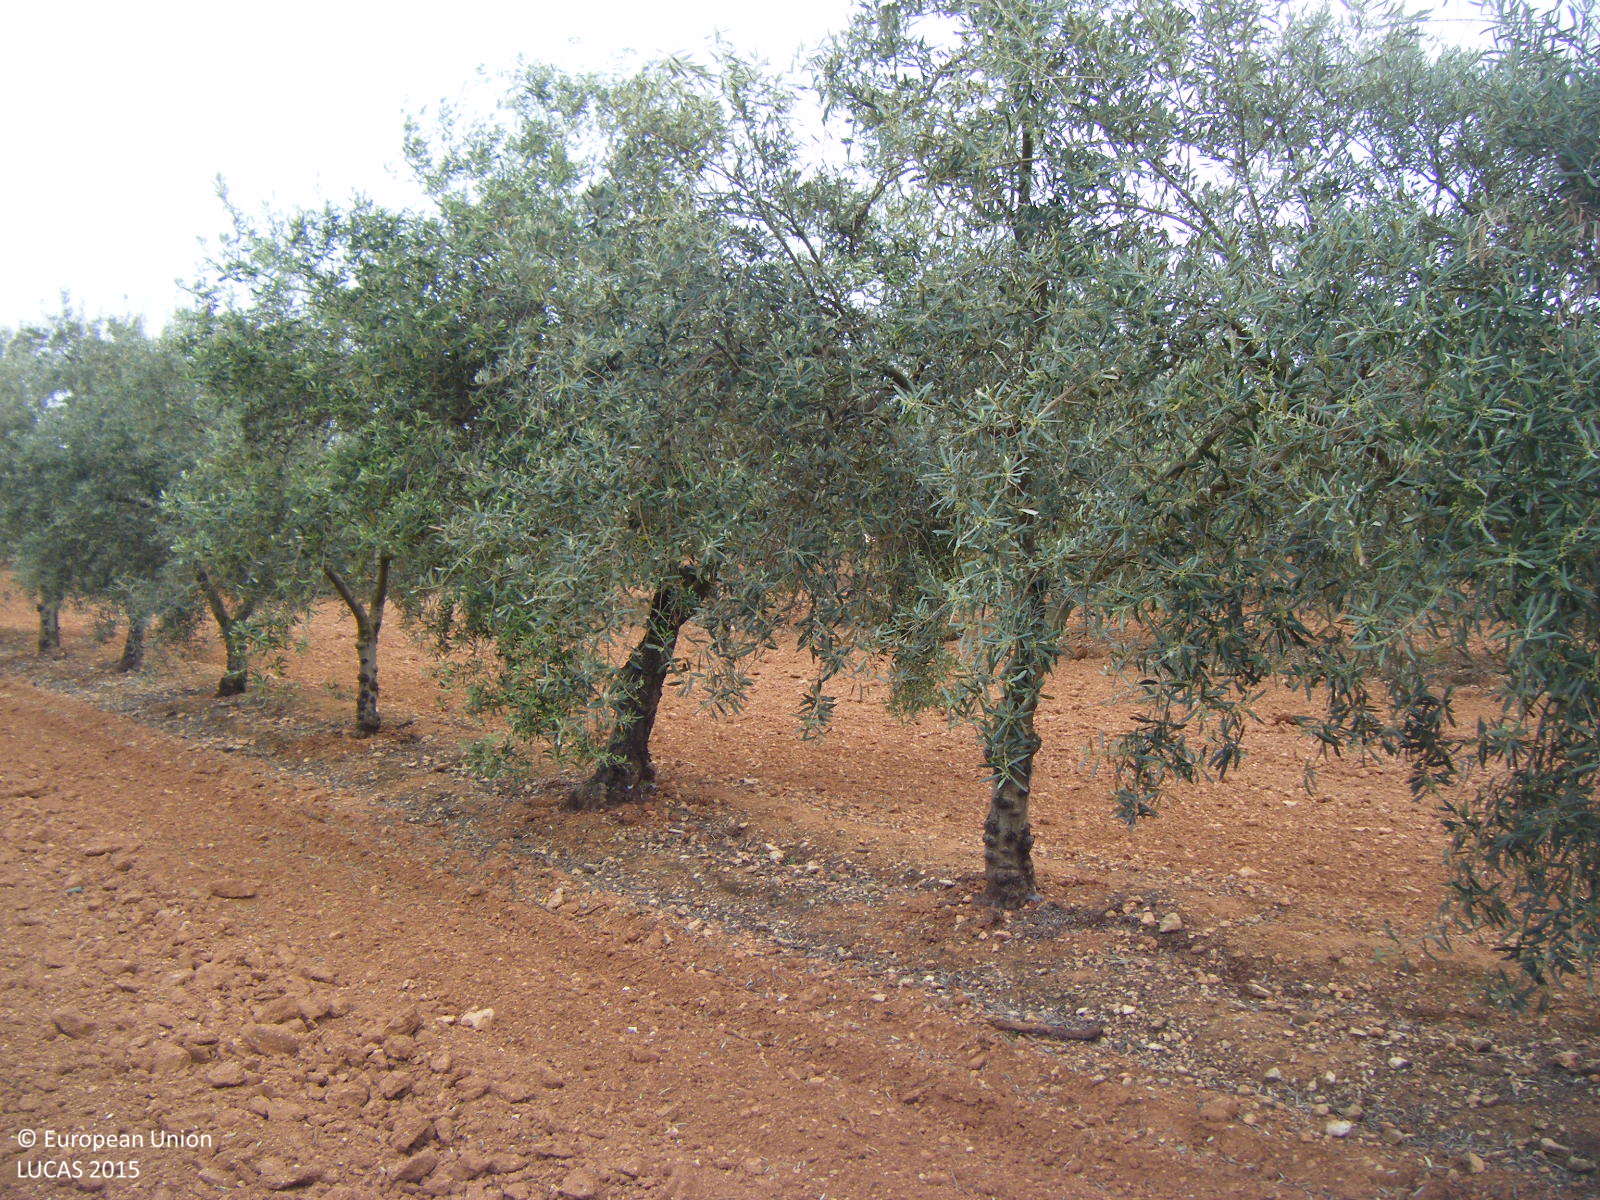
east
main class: Cropland
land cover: Olive groves
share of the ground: 25 - 50 %
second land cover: Other bare soil
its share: > 75 %
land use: Agriculture (excluding fallow land and kitchen gardens)
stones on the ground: < 10 %
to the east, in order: Olive groves; Other bare soil; Grass margins; Tracks; Olive groves
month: April
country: ES
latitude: 37.1907
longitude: -4.7938
